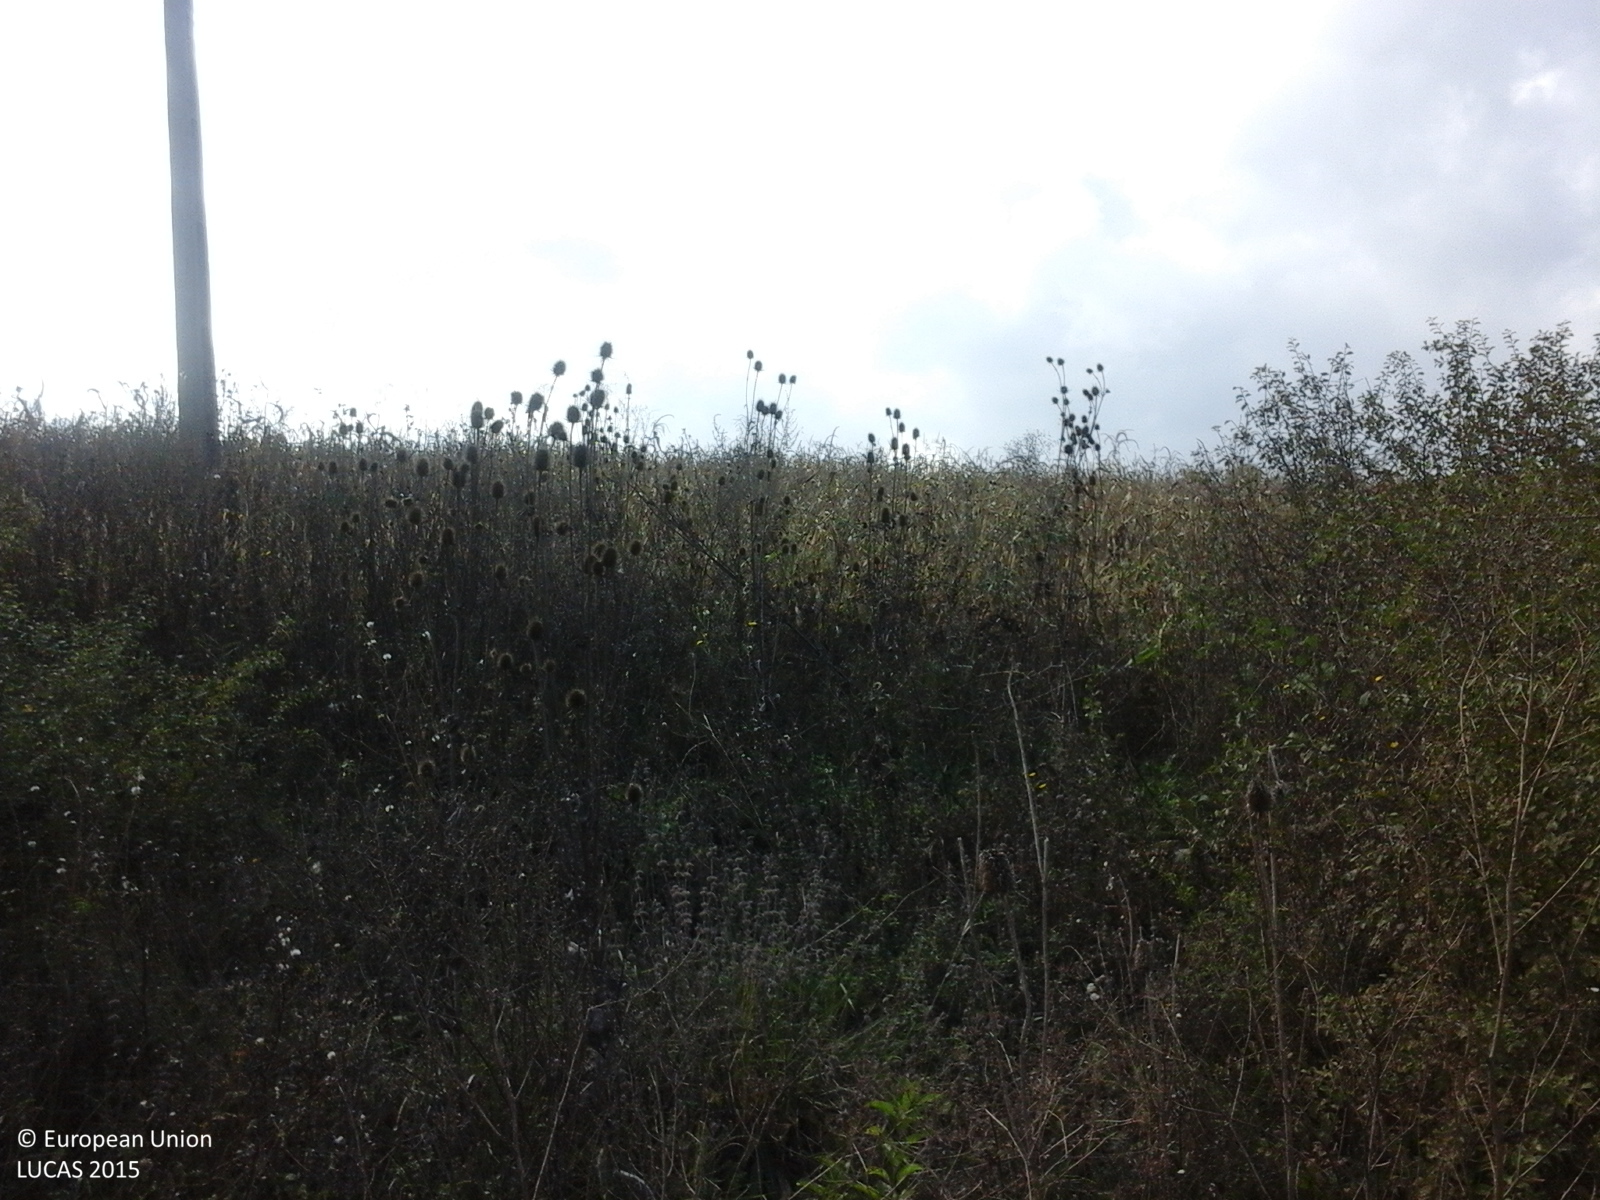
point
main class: Cropland
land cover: Maize
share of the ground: > 75 %
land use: Agriculture (excluding fallow land and kitchen gardens)
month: October
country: RO
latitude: 46.2487
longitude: 24.1248
